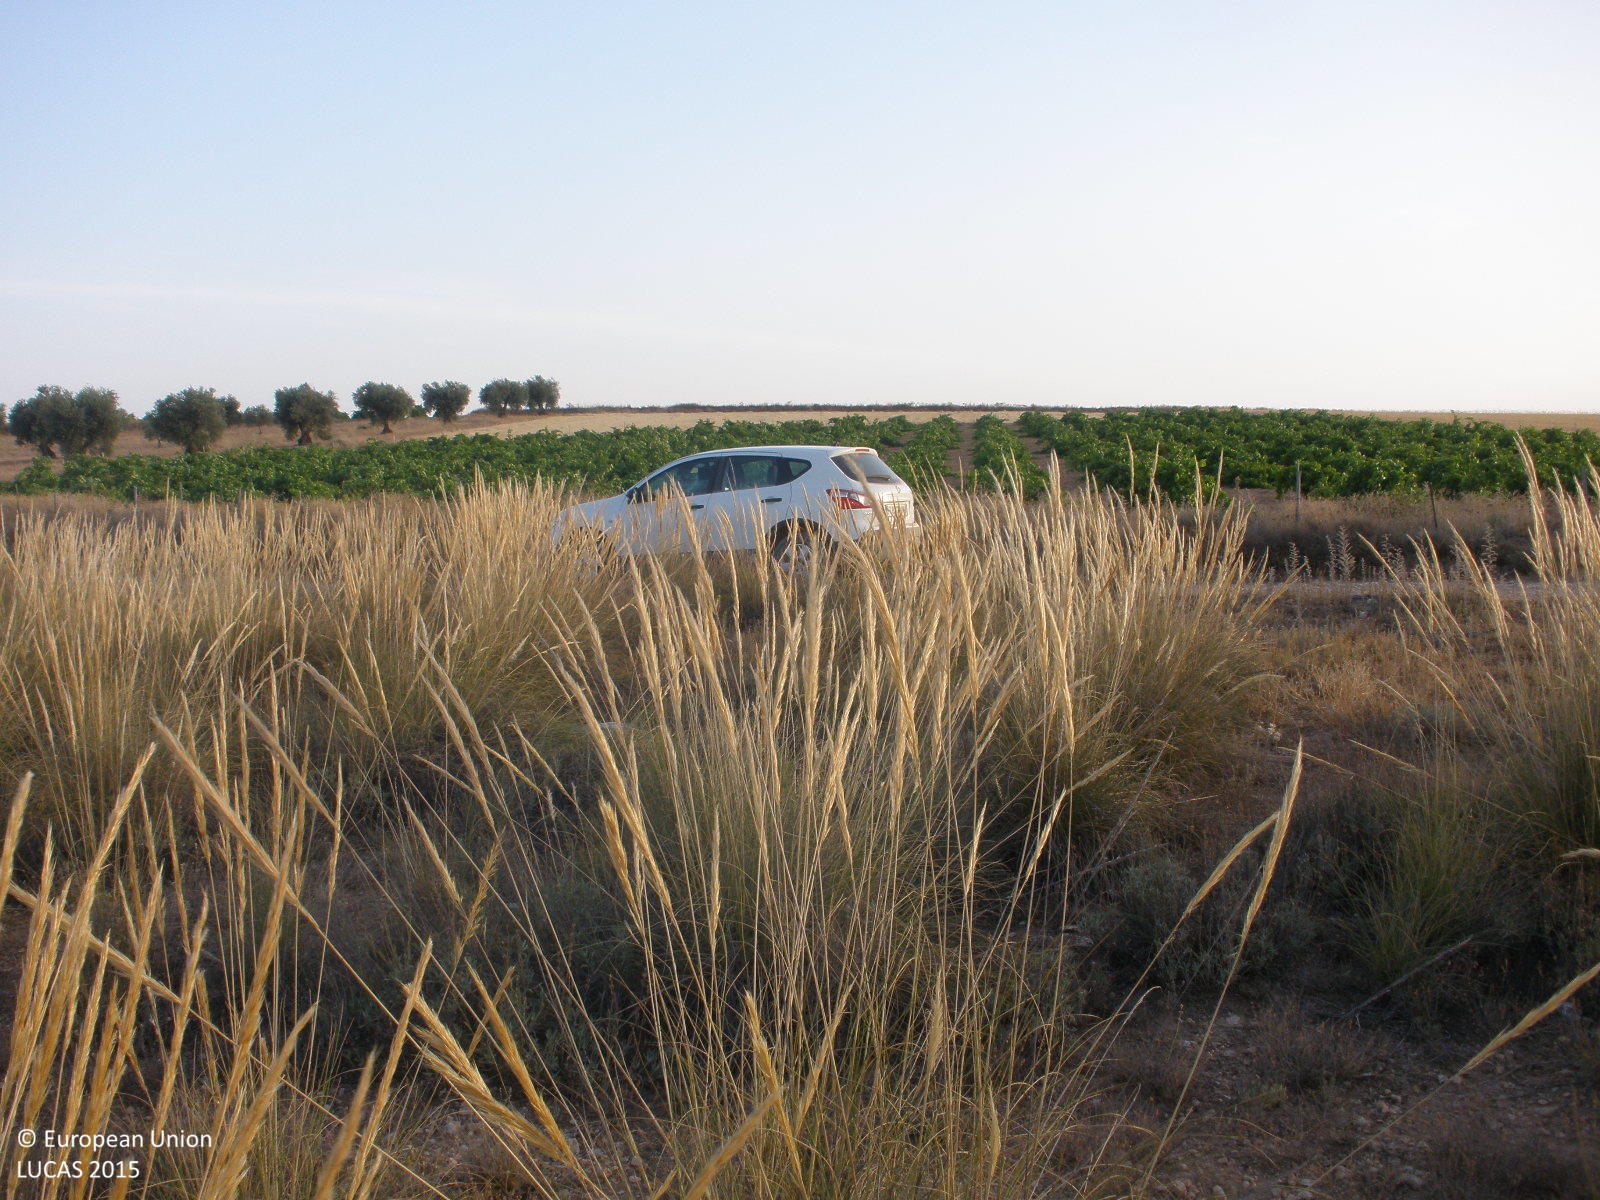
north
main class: Shrubland
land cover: Shrubland without tree cover
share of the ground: 25 - 50 %
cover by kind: herbaceous plants 50 %, shrubs 40 %, consolidated bare surface 10 %
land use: Semi-natural and natural areas not in use
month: July
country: ES
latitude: 40.0004
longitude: -3.4168
